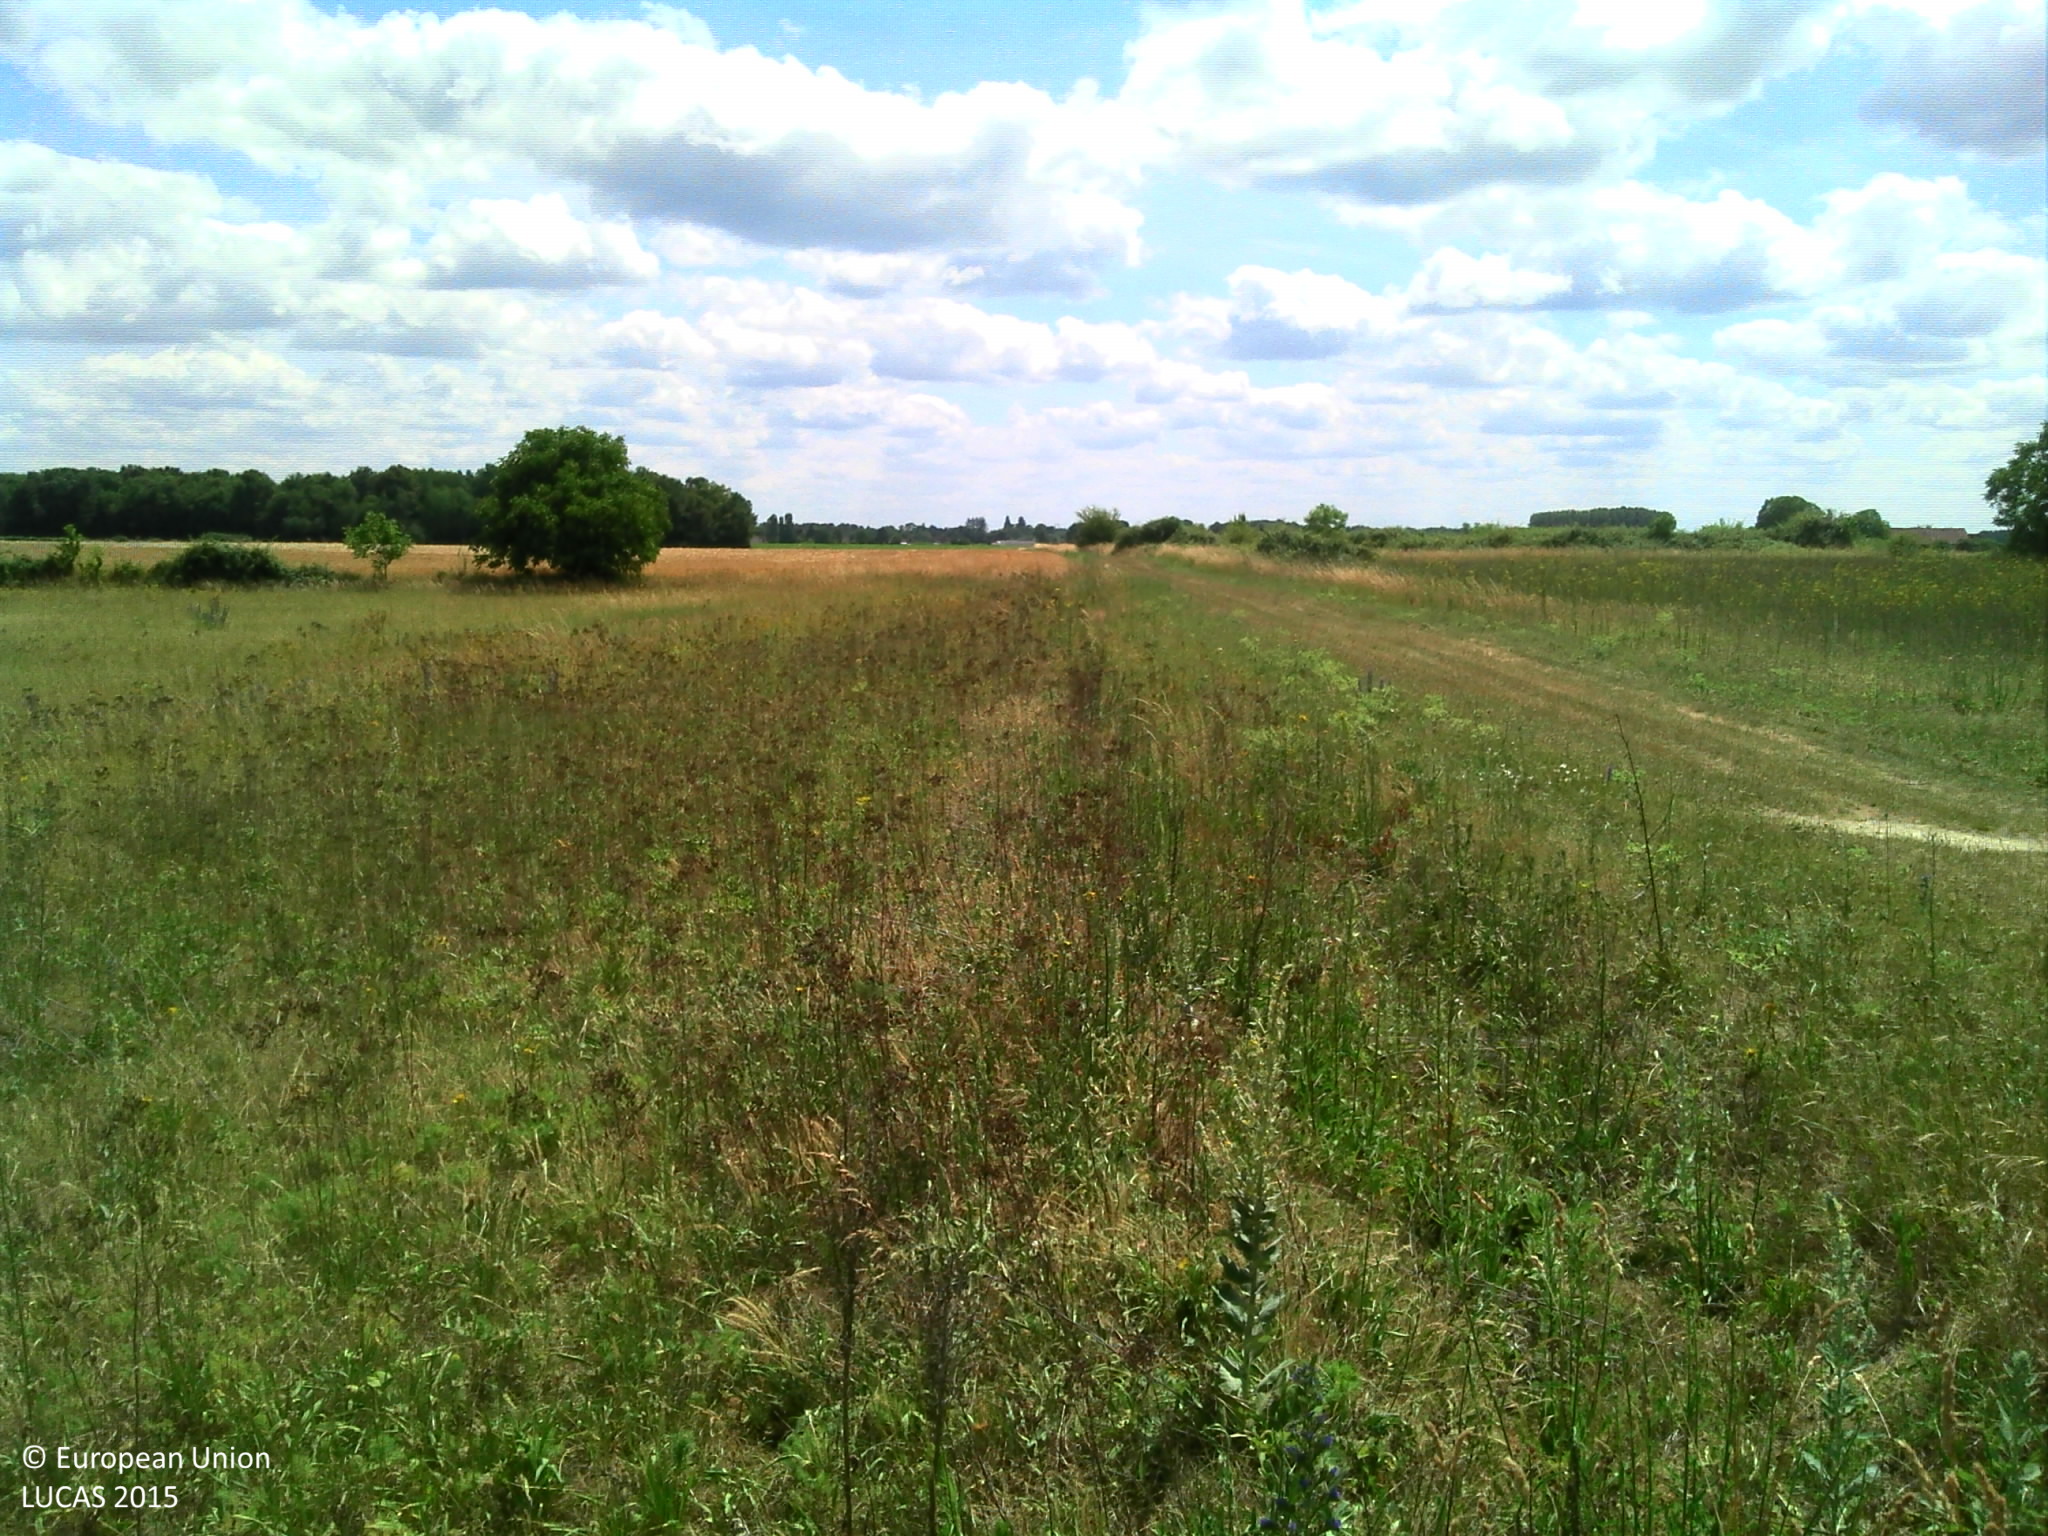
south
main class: Grassland
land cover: Grassland without tree/shrub cover
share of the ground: > 75 %
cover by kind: herbaceous plants 100 %
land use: Agriculture (excluding fallow land and kitchen gardens)
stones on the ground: < 10 %
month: June
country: FR
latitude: 47.4334
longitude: 0.3117
